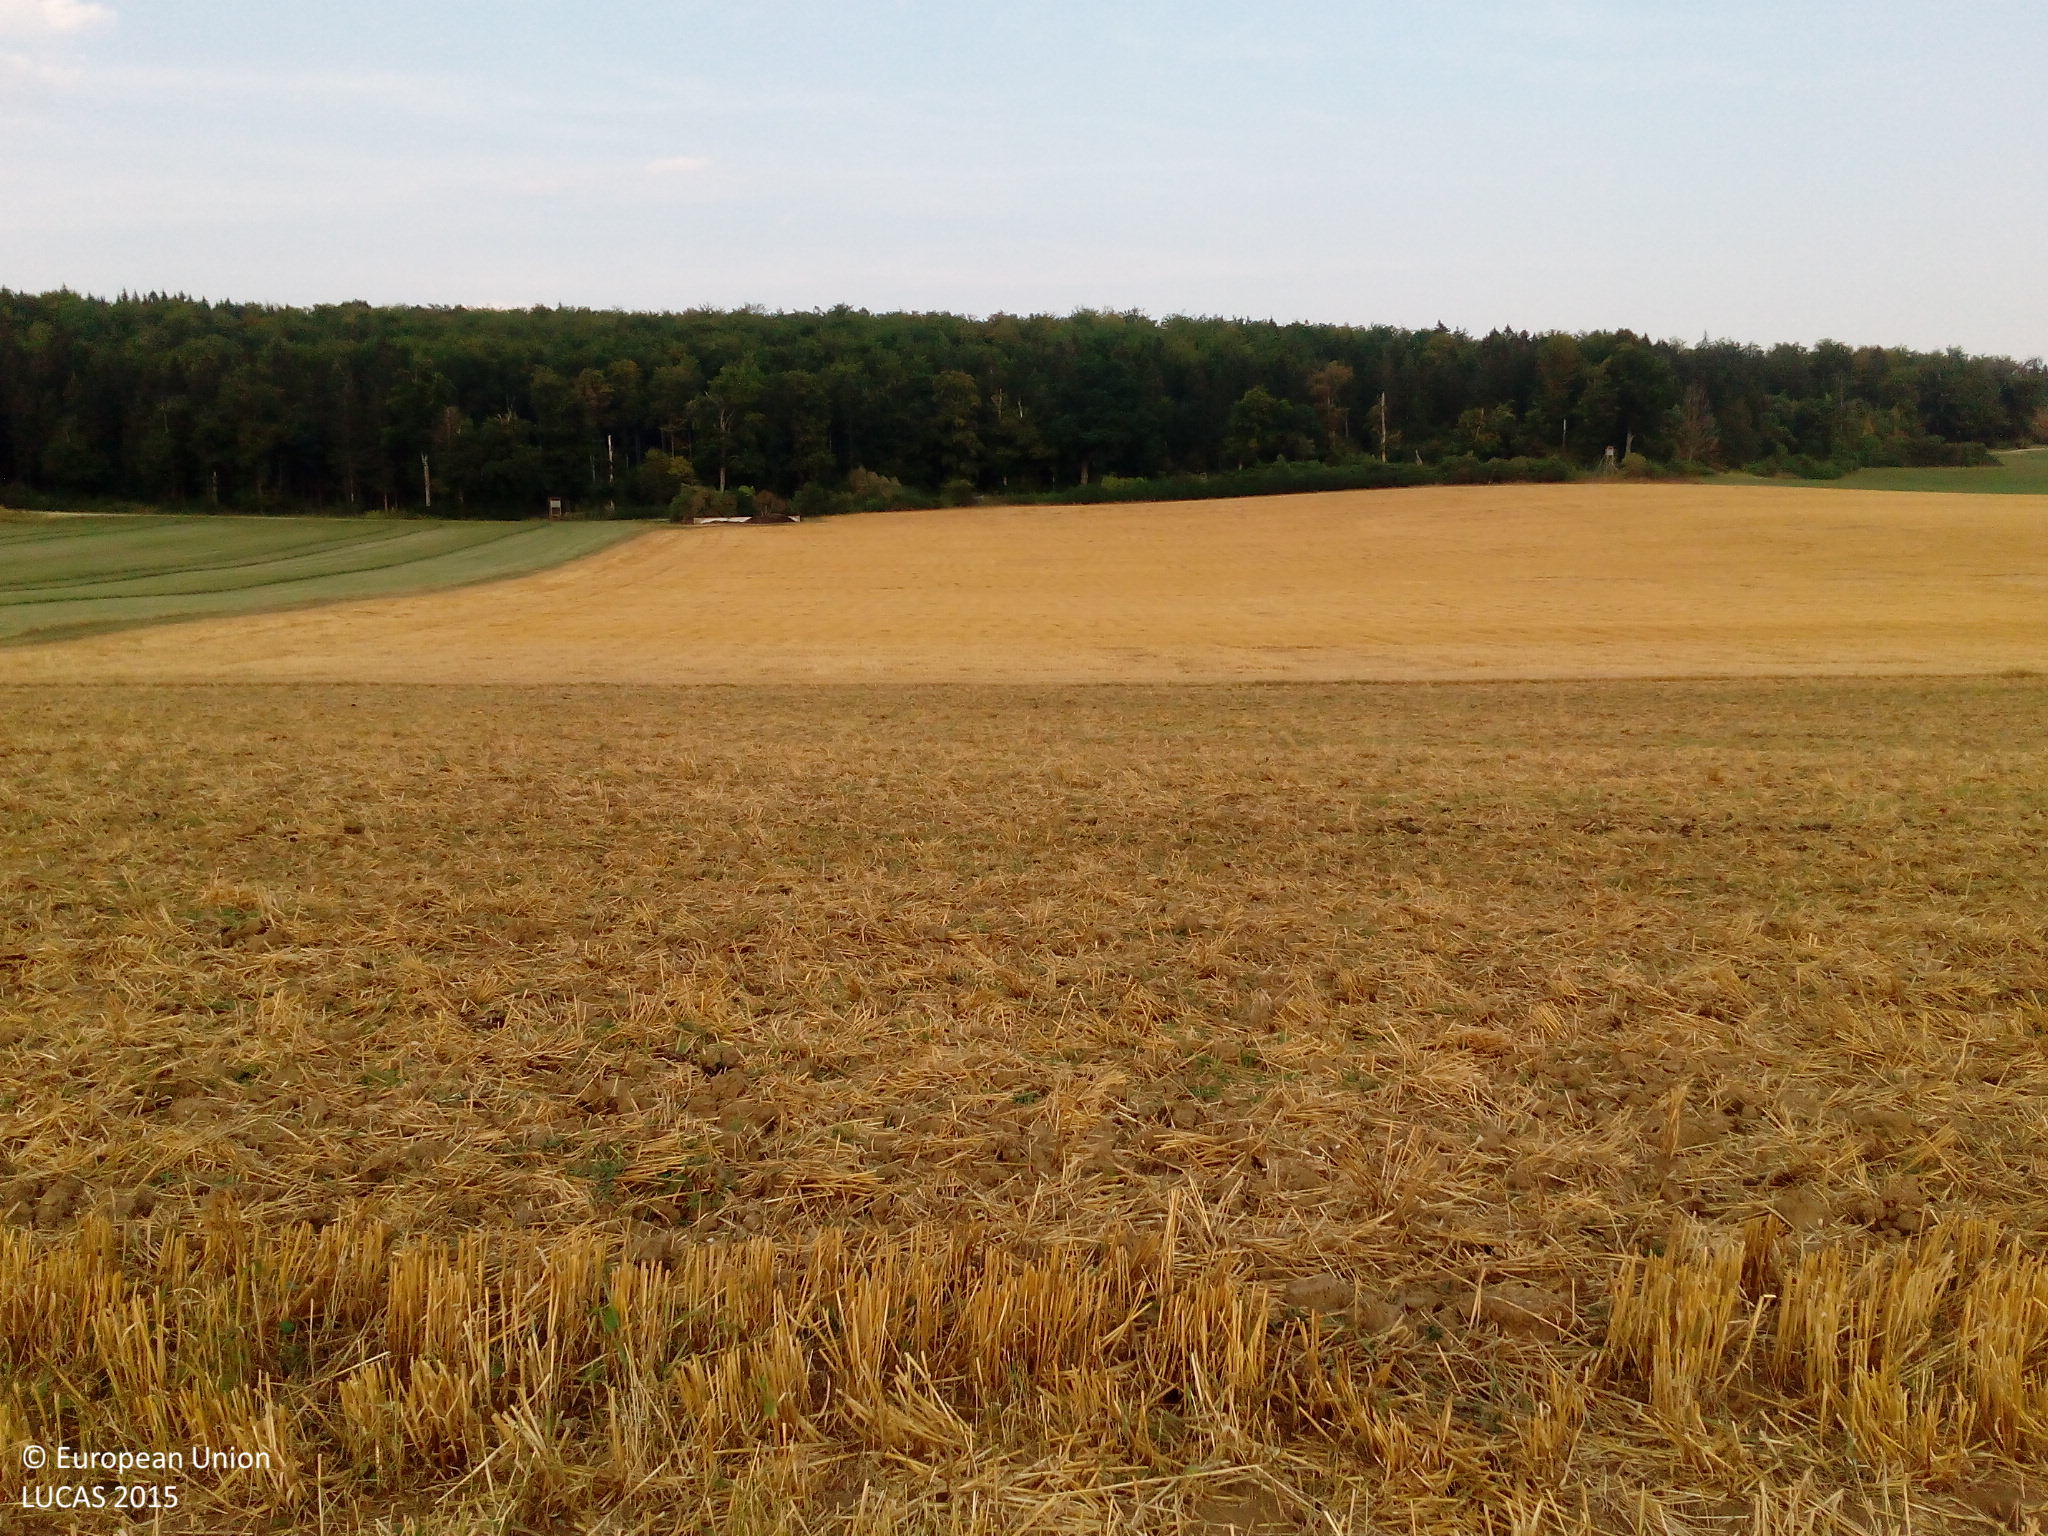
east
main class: Cropland
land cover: Common wheat
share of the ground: > 75 %
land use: Agriculture (excluding fallow land and kitchen gardens)
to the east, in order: Common wheat; Barley
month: August
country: DE
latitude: 48.7090
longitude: 10.2581
